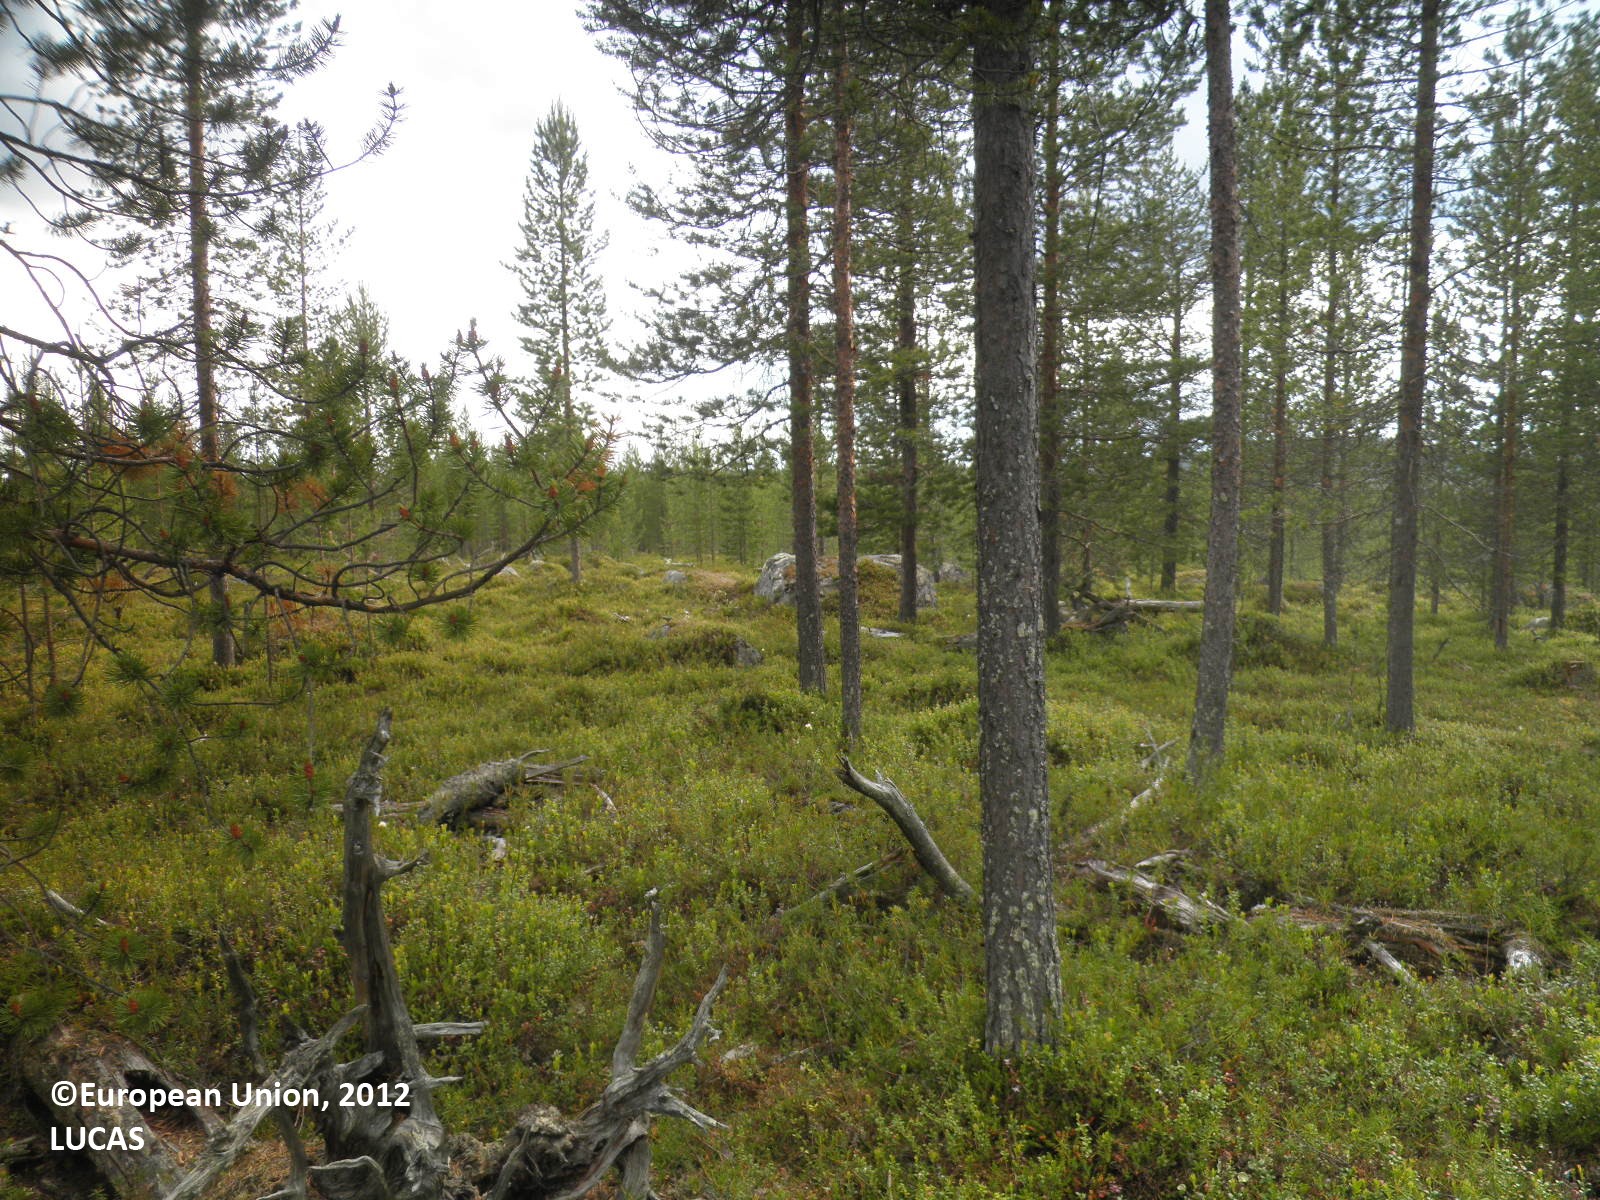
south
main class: Woodland
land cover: Pine dominated coniferous woodland
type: boreal forest
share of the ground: 25 - 50 %
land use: Forestry
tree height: > 5 m
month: July
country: FI
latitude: 68.6455
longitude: 27.8289
